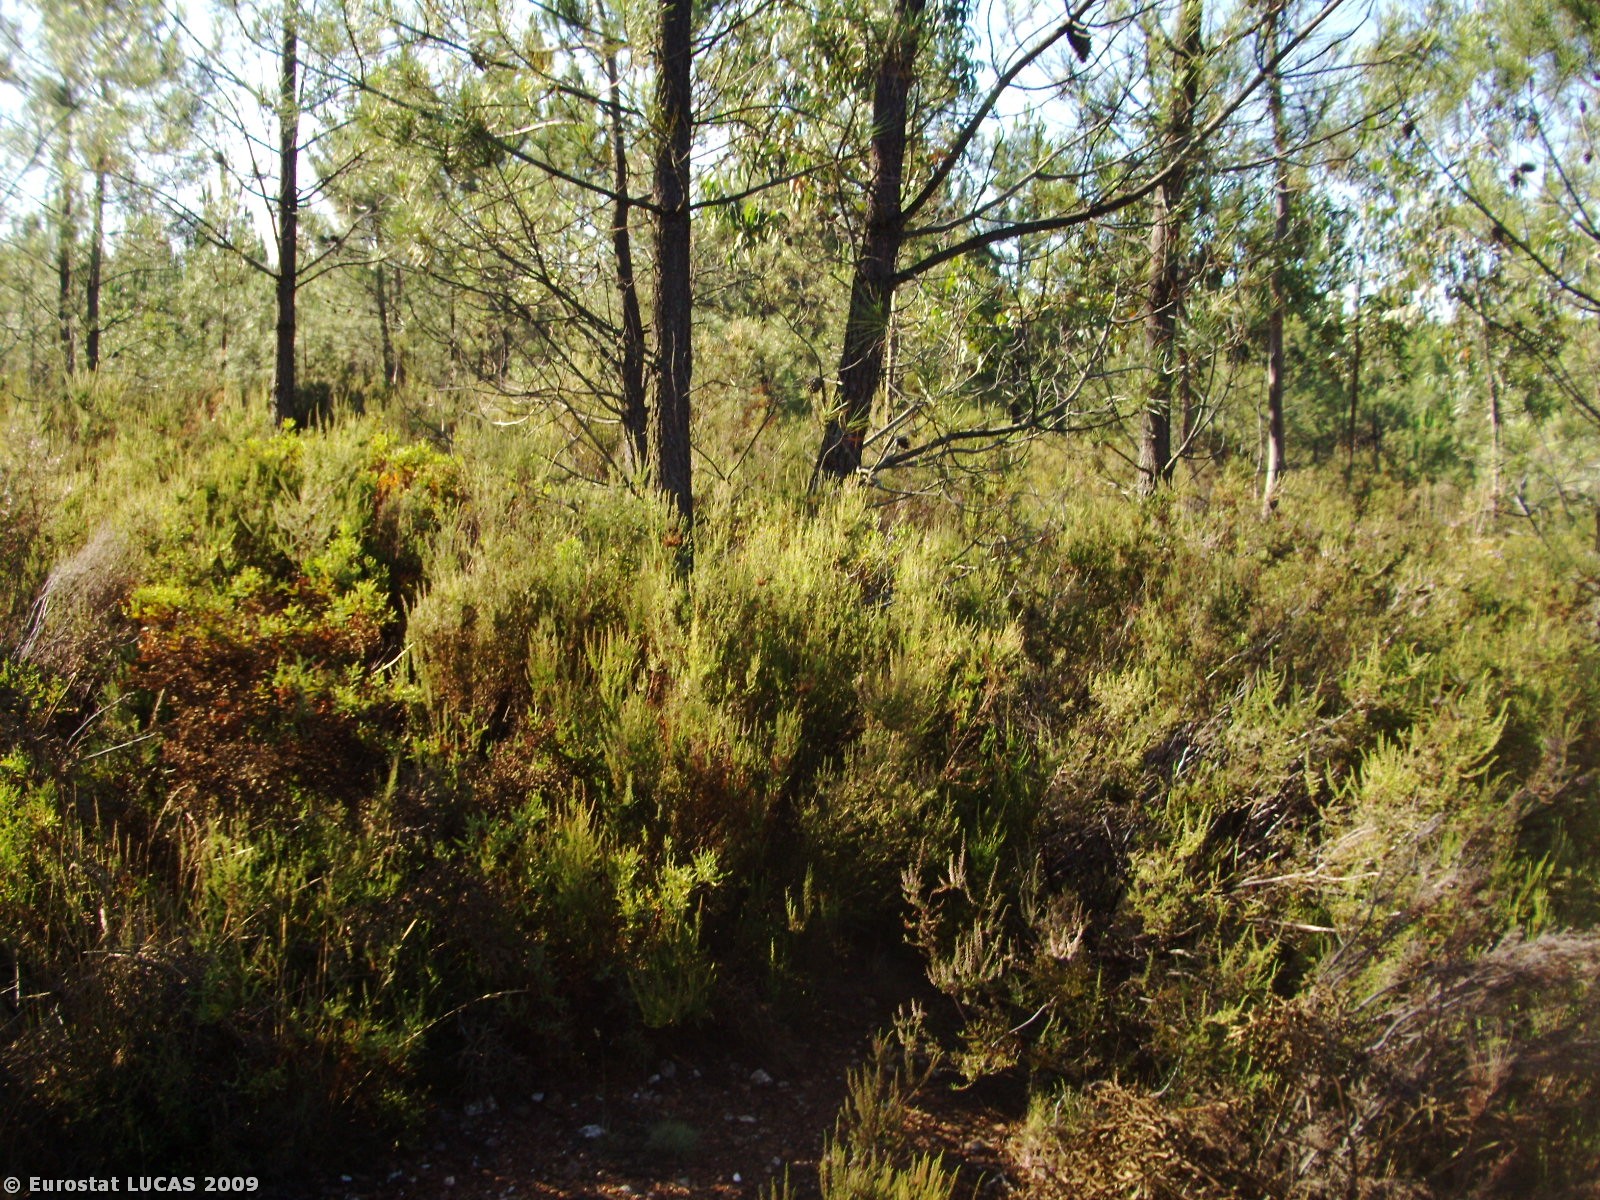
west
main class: Woodland
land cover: Coniferous woodland
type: coniferous forest of the mediterranean region
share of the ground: > 75 %
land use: Forestry
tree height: > 5 m
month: July
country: PT
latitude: 40.2256
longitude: -7.6318
